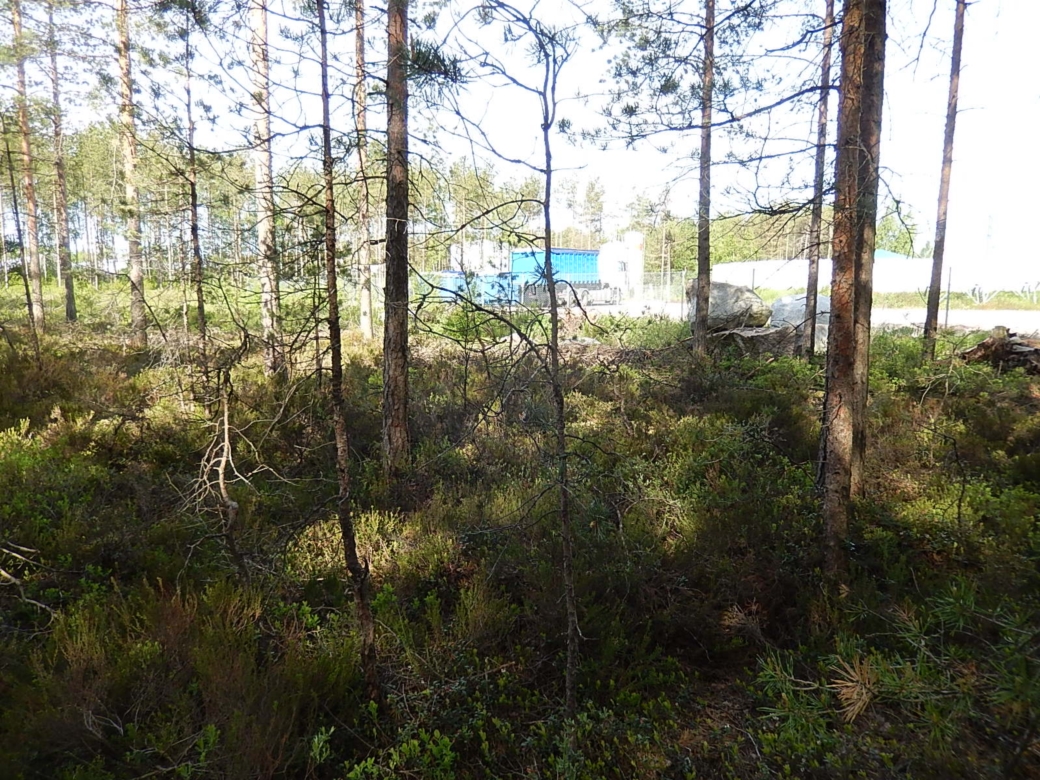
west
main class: Woodland
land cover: Pine dominated coniferous woodland
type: boreal forest
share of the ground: > 75 %
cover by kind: coniferous forest trees 75 %, shrubs 15 %, broadleaved forest trees 10 %
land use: Forestry
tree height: > 5 m
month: June
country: FI
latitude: 61.9789
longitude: 22.2876
